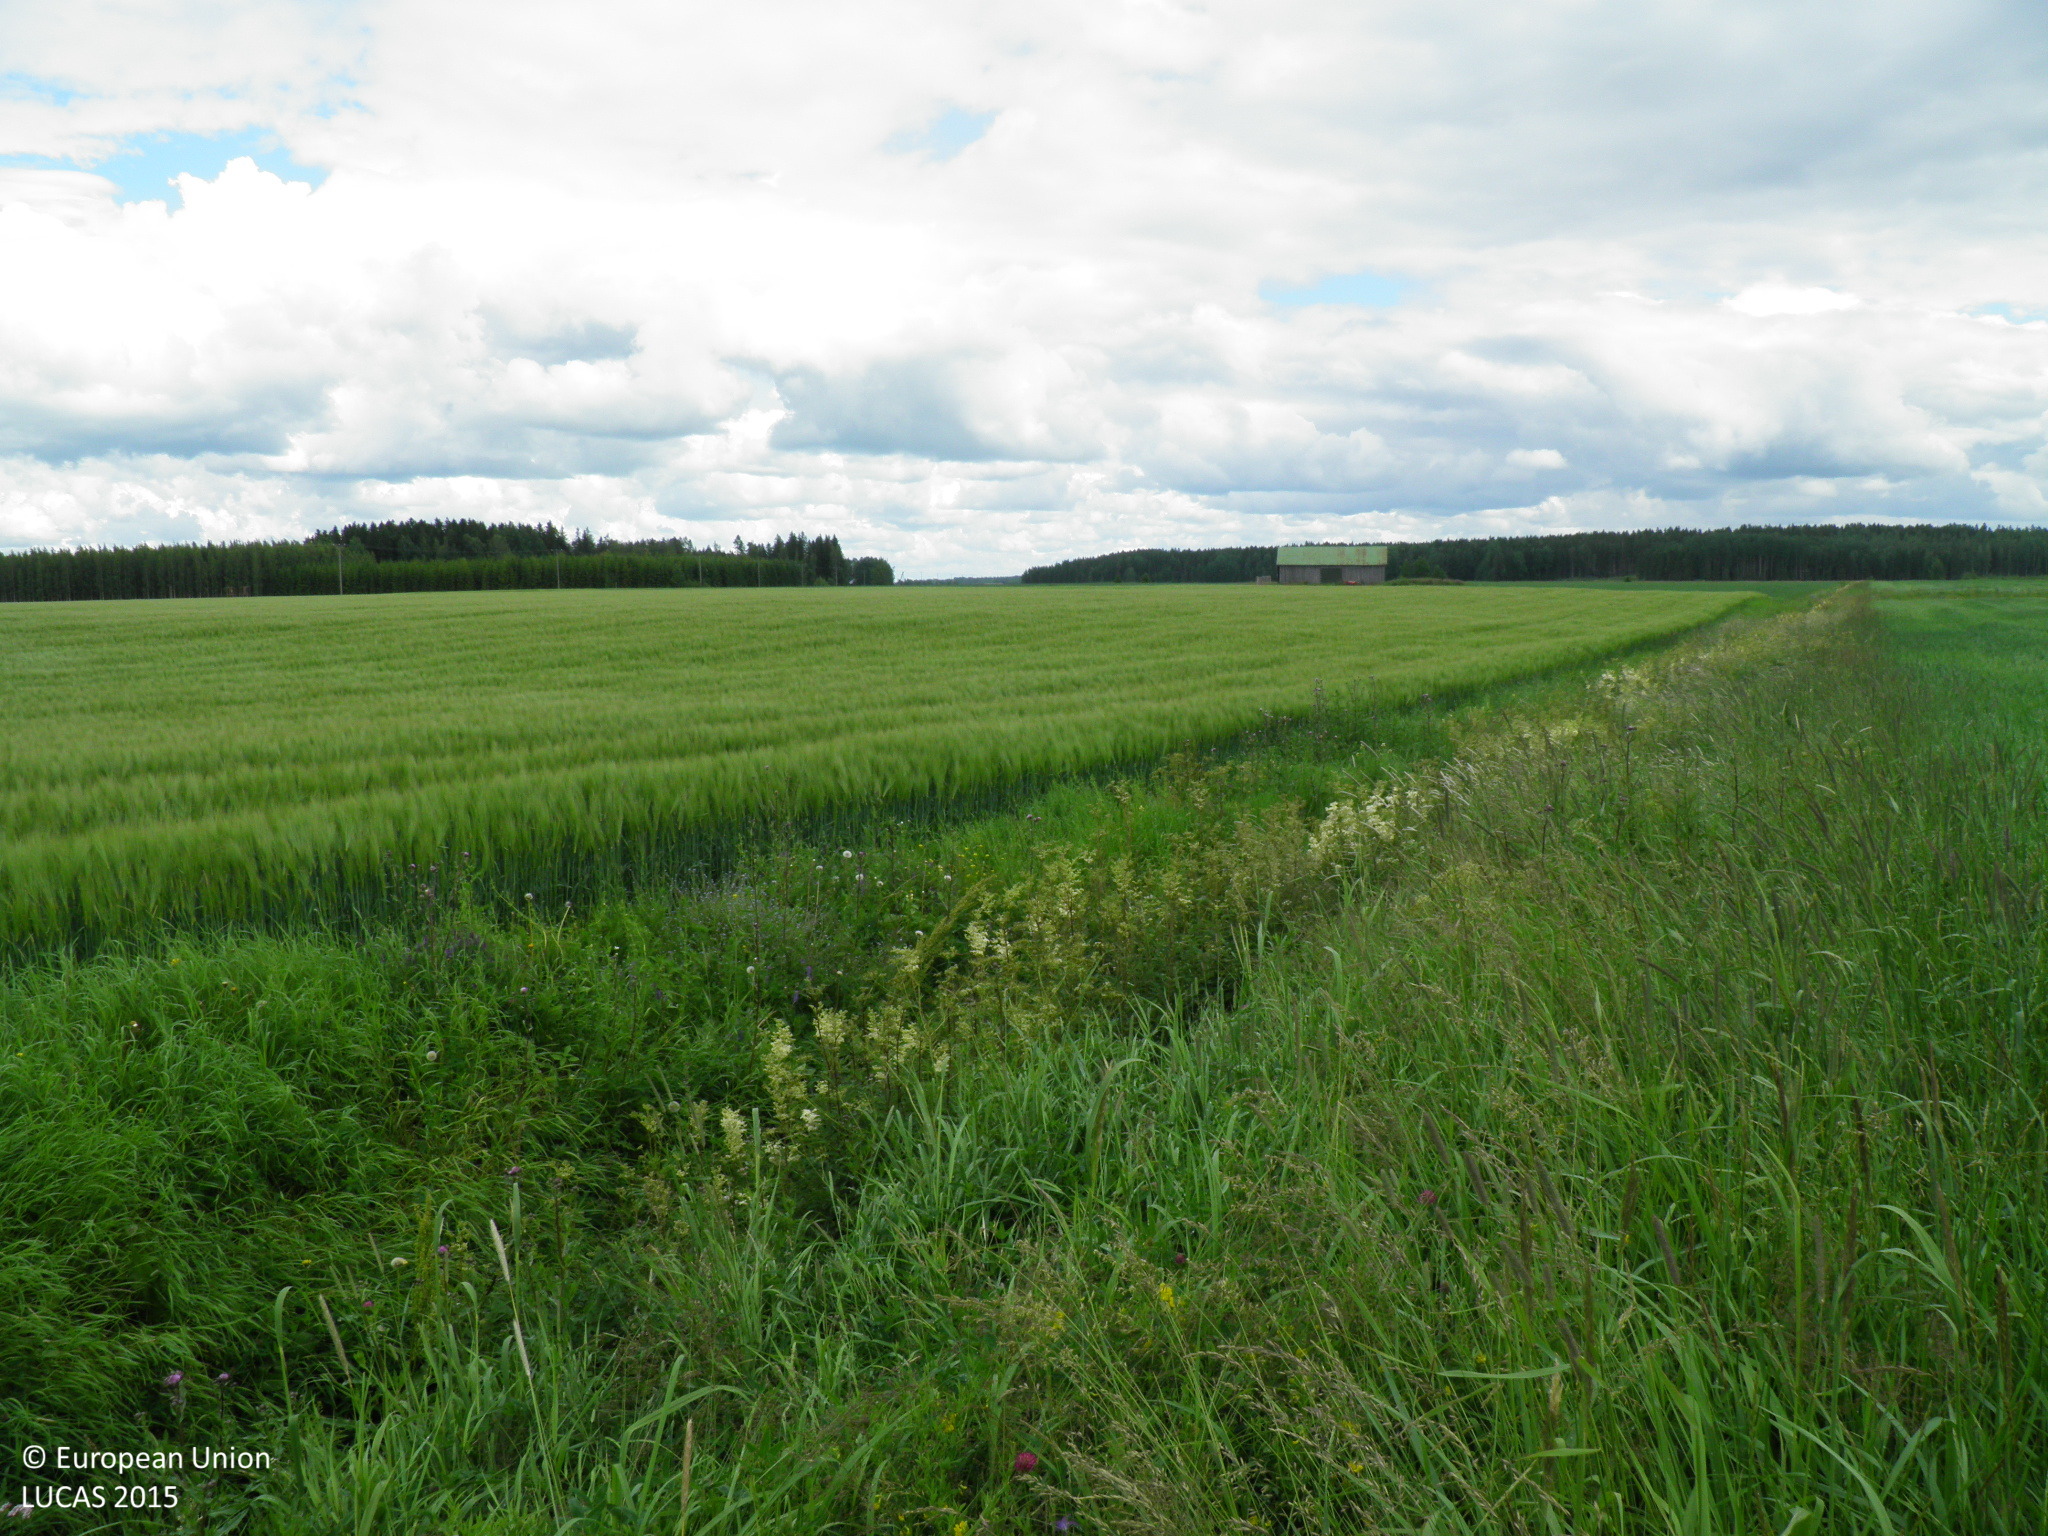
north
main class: Cropland
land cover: Oats
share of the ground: > 75 %
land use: Agriculture (excluding fallow land and kitchen gardens)
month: July
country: FI
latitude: 60.7838
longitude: 22.9874
